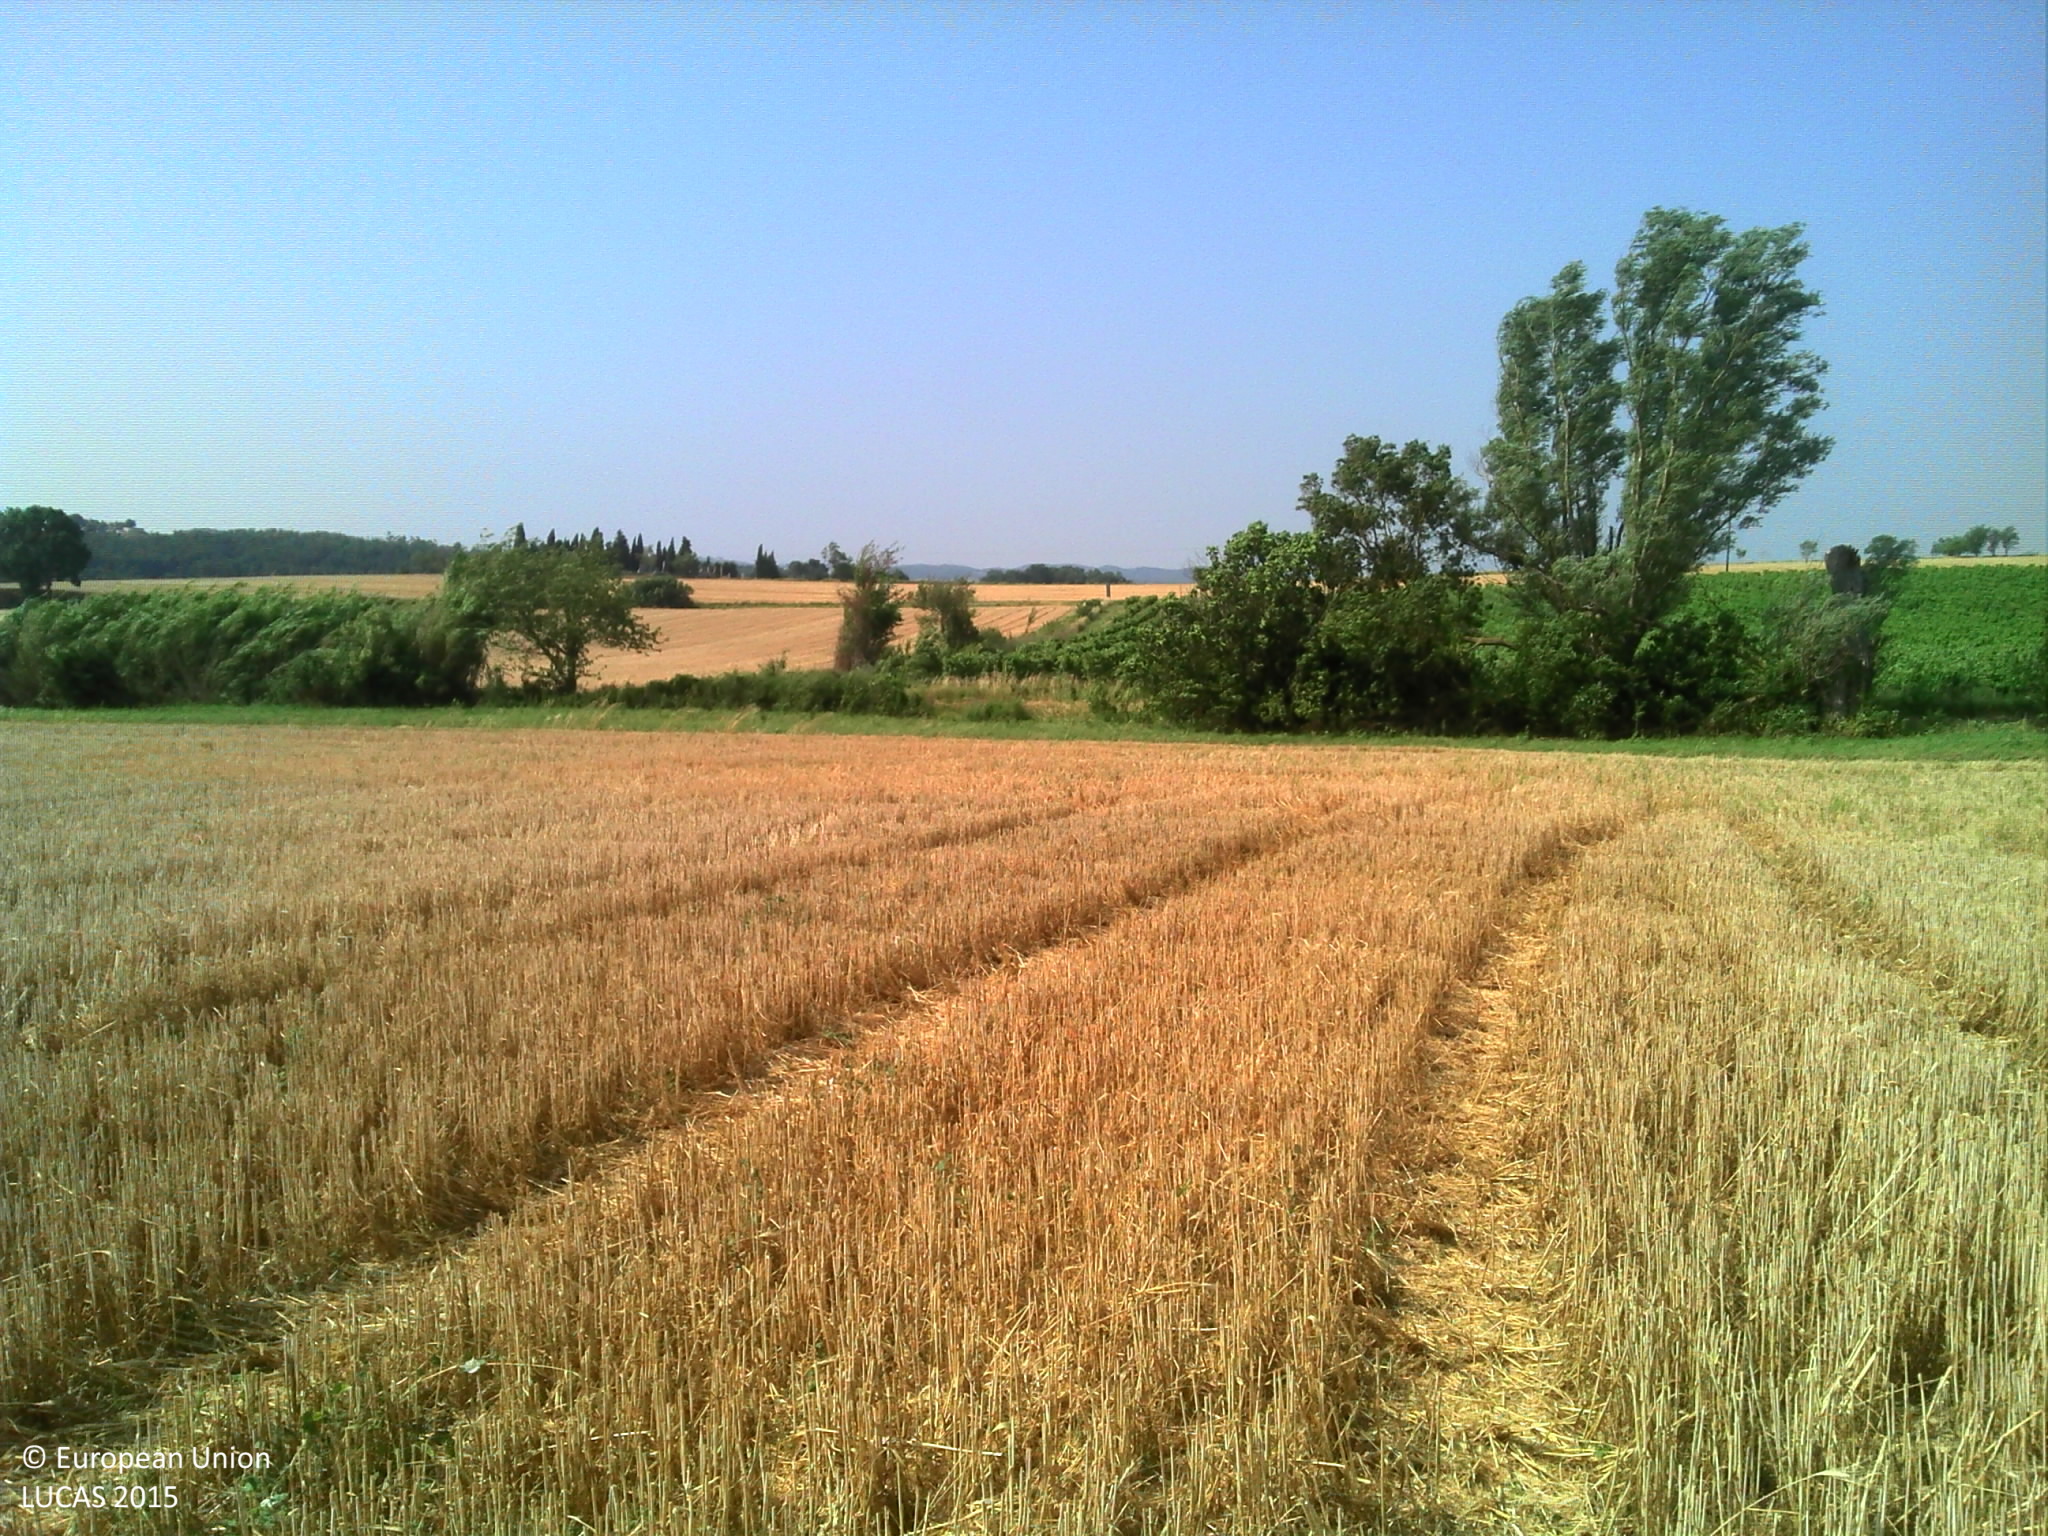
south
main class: Cropland
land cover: Durum wheat
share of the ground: > 75 %
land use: Agriculture (excluding fallow land and kitchen gardens)
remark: Harvested field
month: July
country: FR
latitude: 43.1412
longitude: 2.0774
